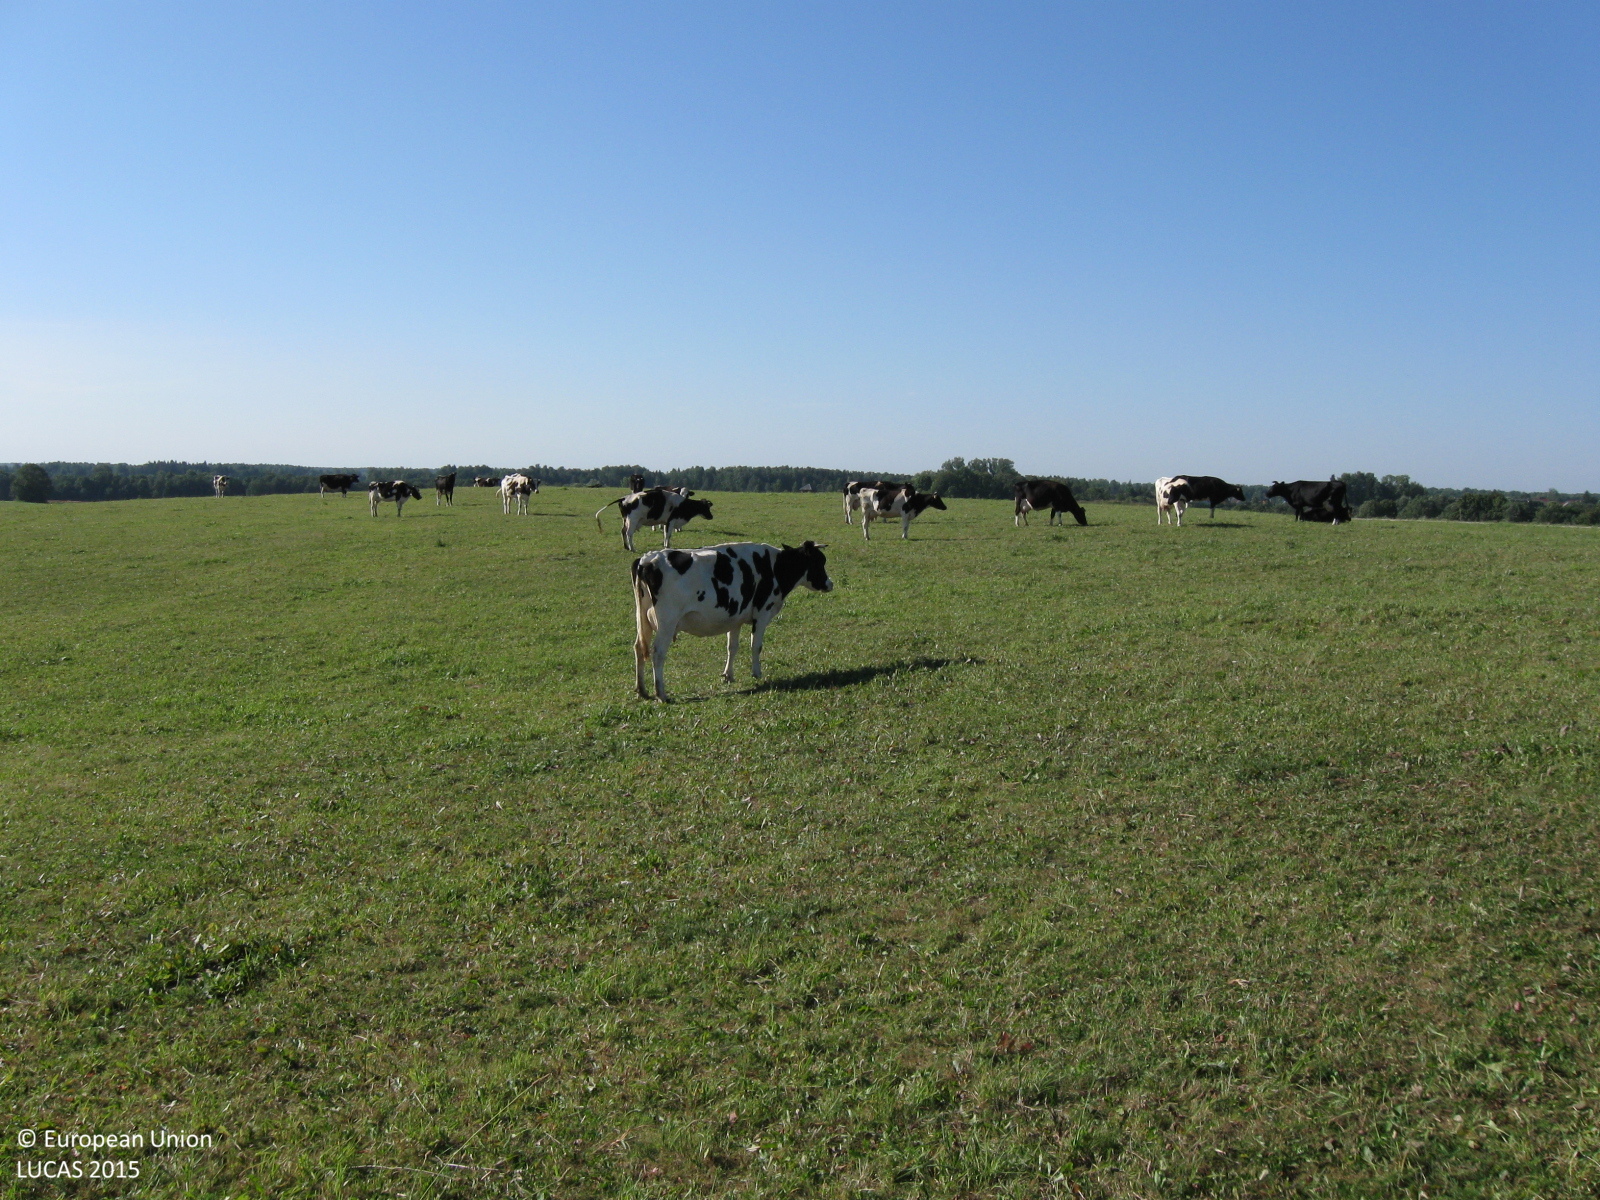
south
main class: Grassland
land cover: Grassland without tree/shrub cover
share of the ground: > 75 %
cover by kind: herbaceous plants 100 %
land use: Agriculture (excluding fallow land and kitchen gardens)
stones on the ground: < 10 %
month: August
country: LT
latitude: 55.4250
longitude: 22.5284
